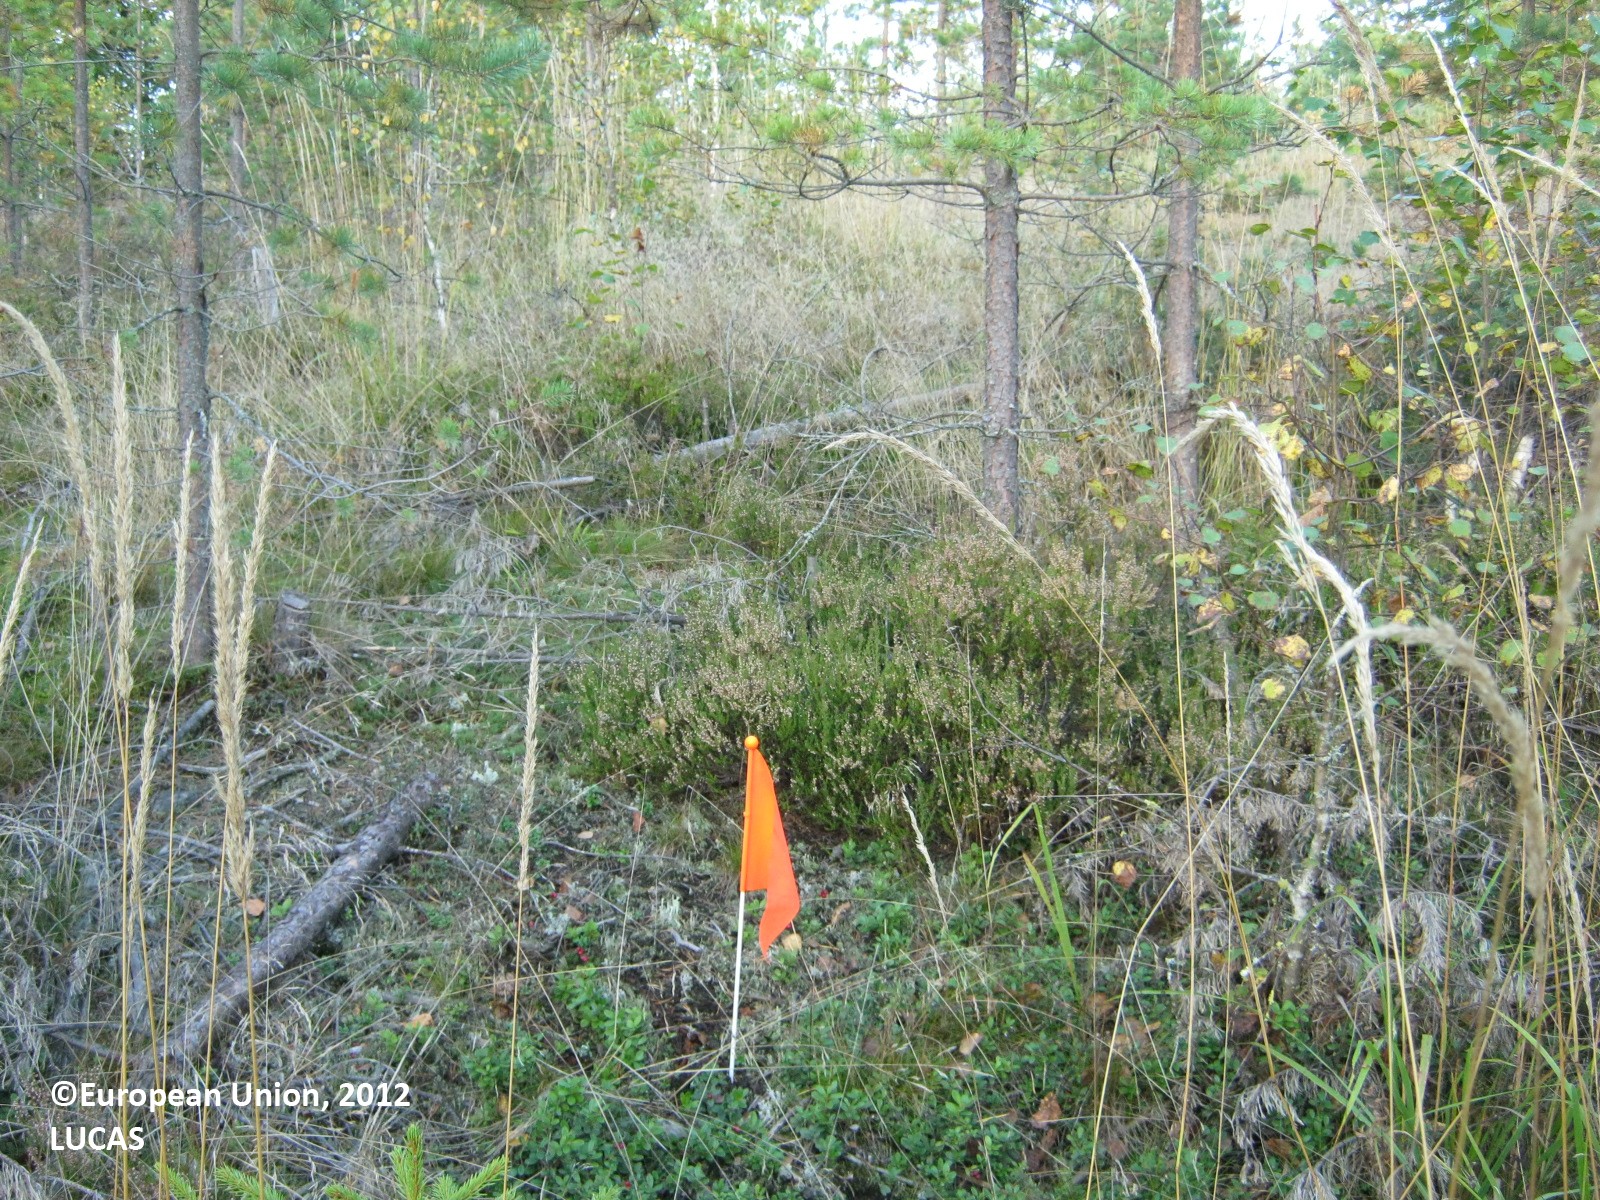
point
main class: Woodland
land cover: Pine dominated coniferous woodland
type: boreal forest
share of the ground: > 75 %
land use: Forestry
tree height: < 5 m
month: September
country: FI
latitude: 60.7750
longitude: 27.9547
